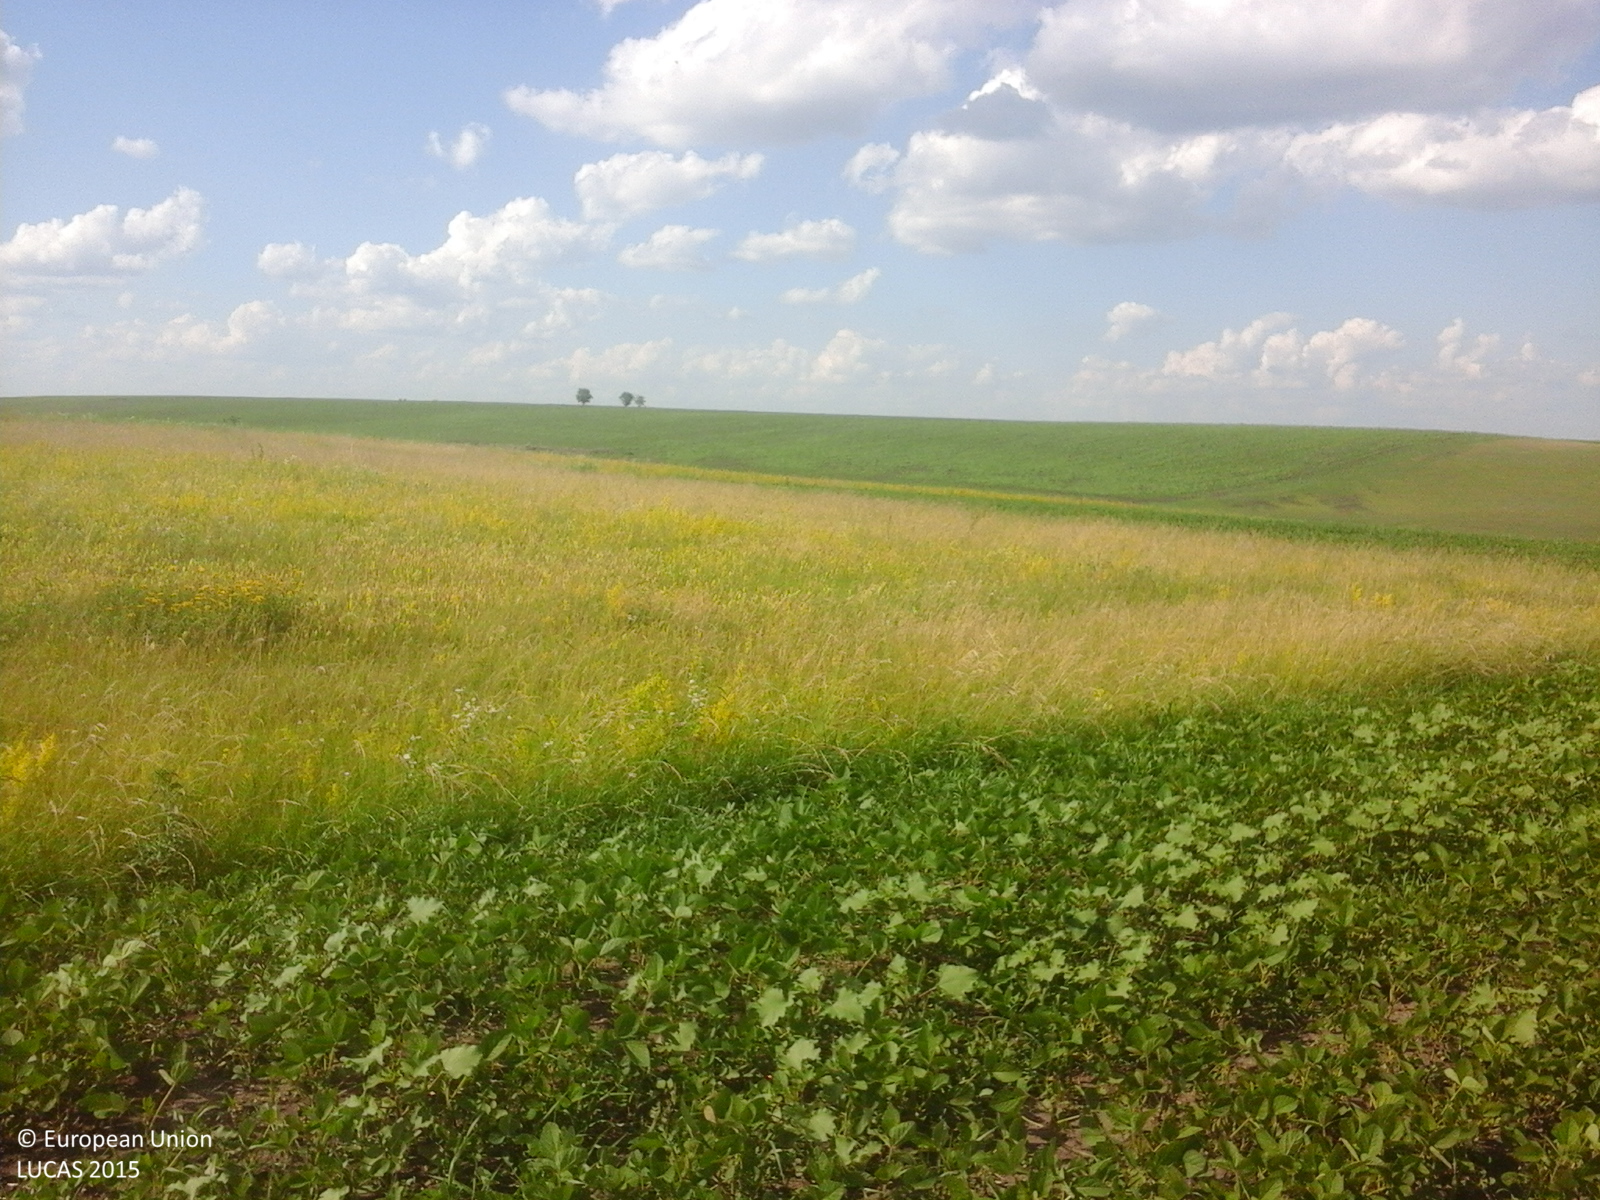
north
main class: Cropland
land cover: Soya
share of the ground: > 75 %
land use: Agriculture (excluding fallow land and kitchen gardens)
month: June
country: RO
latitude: 48.2069
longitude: 26.6903
